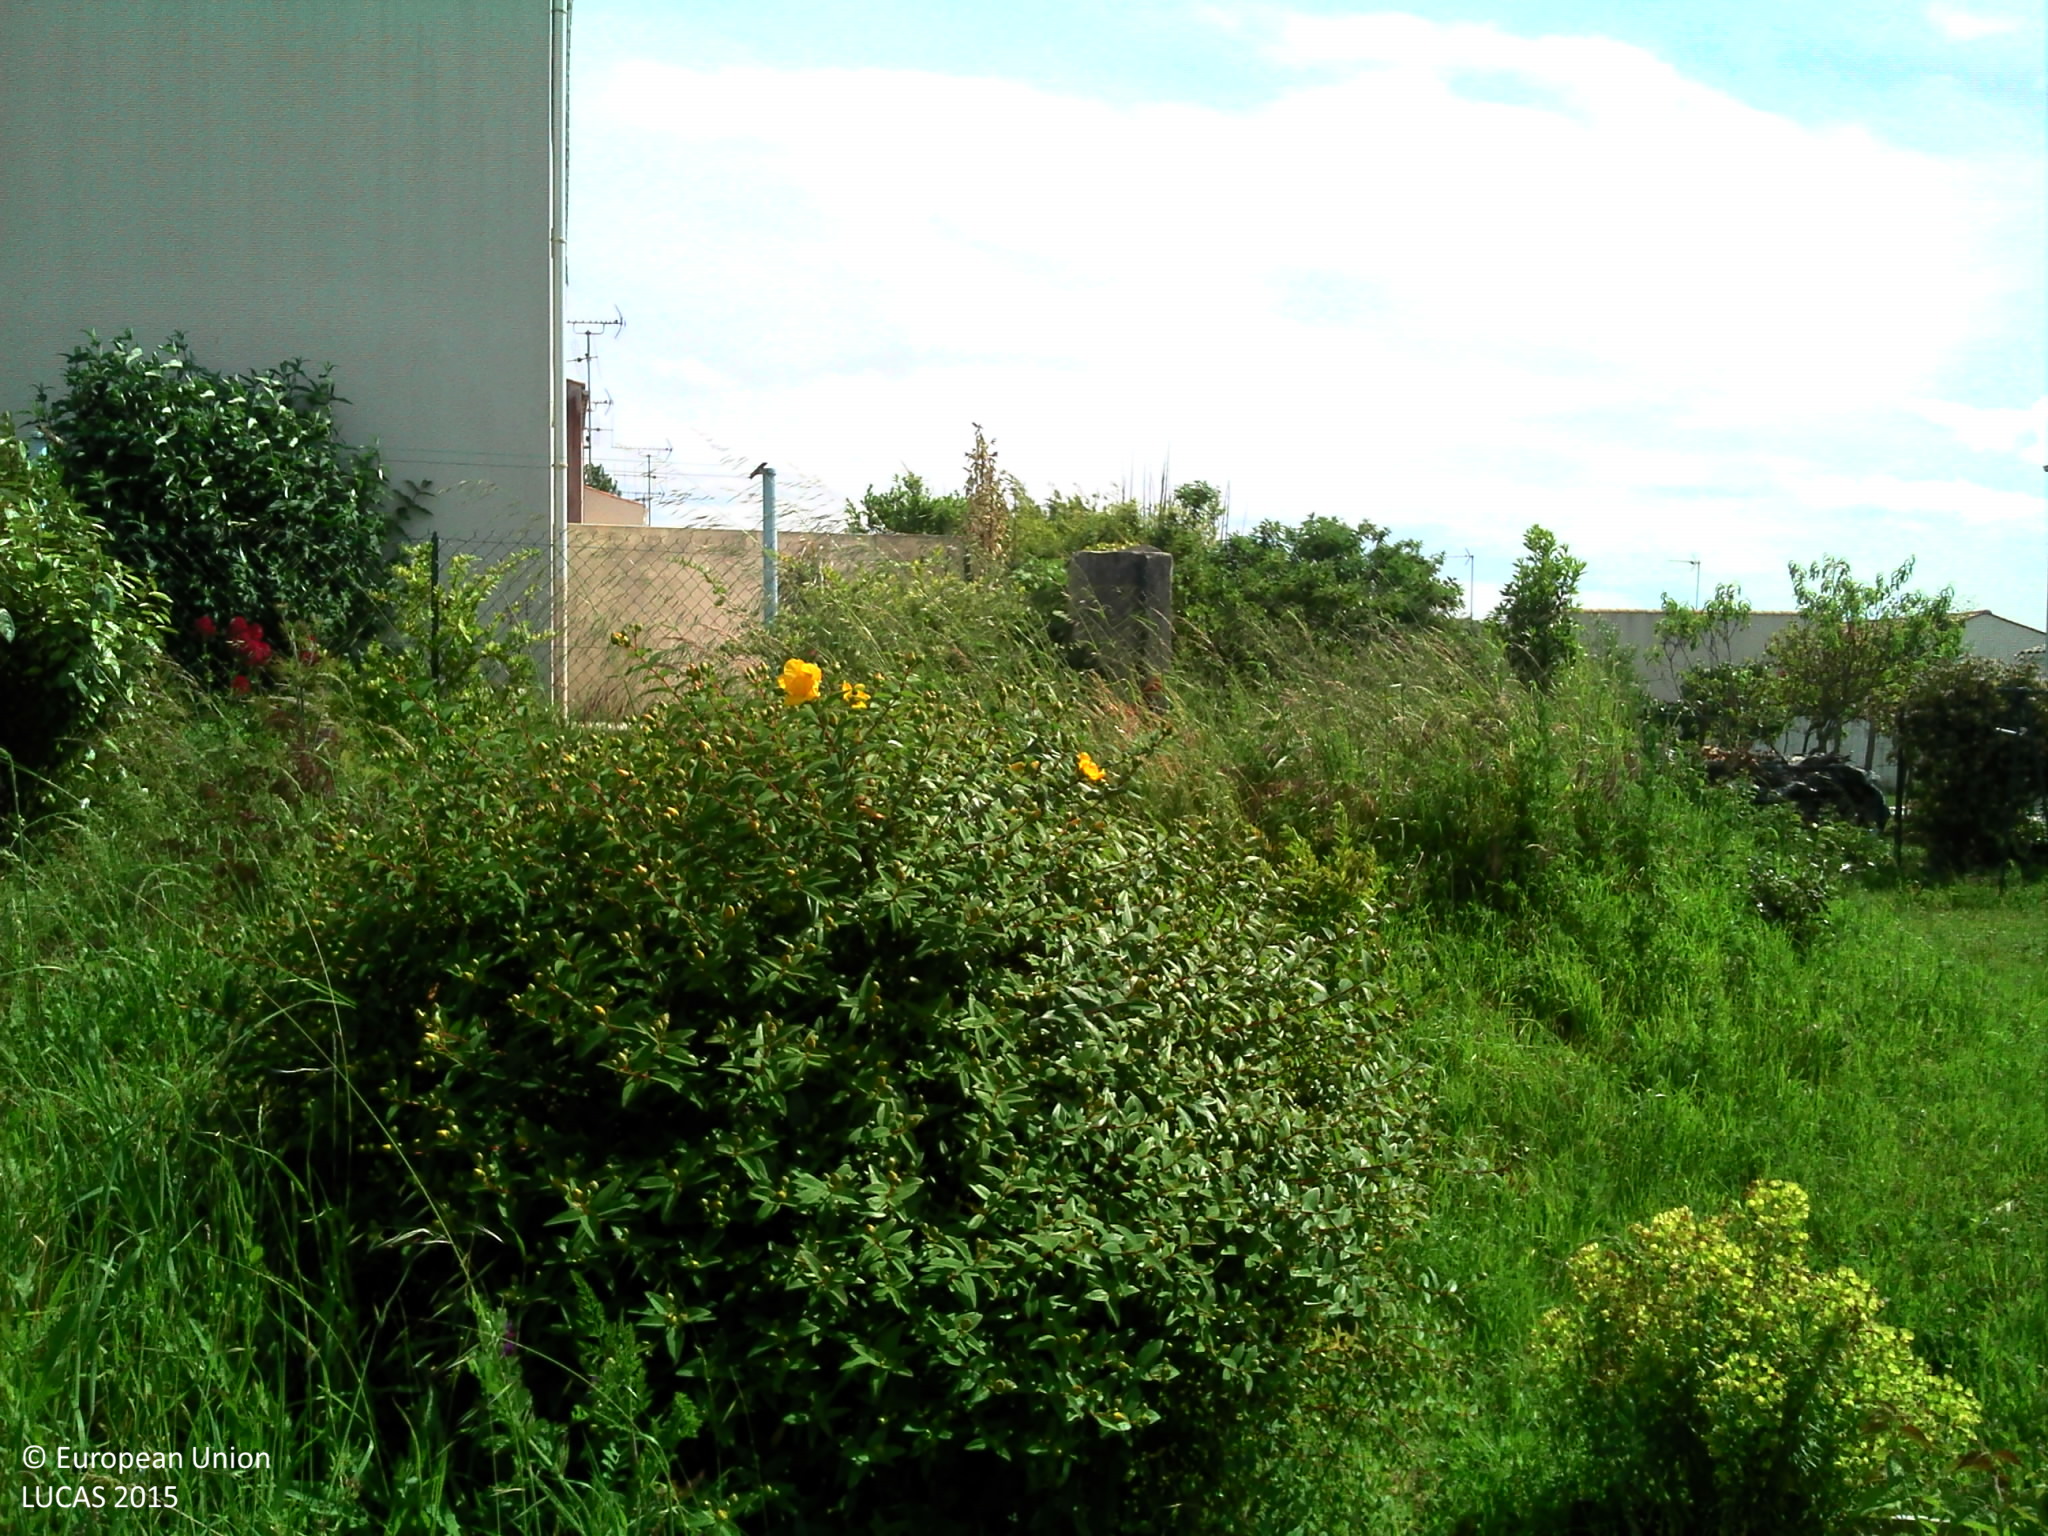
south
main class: Grassland
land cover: Grassland without tree/shrub cover
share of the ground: > 75 %
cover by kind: herbaceous plants 100 %
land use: Residential
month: June
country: FR
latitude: 46.3087
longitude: -1.0031
